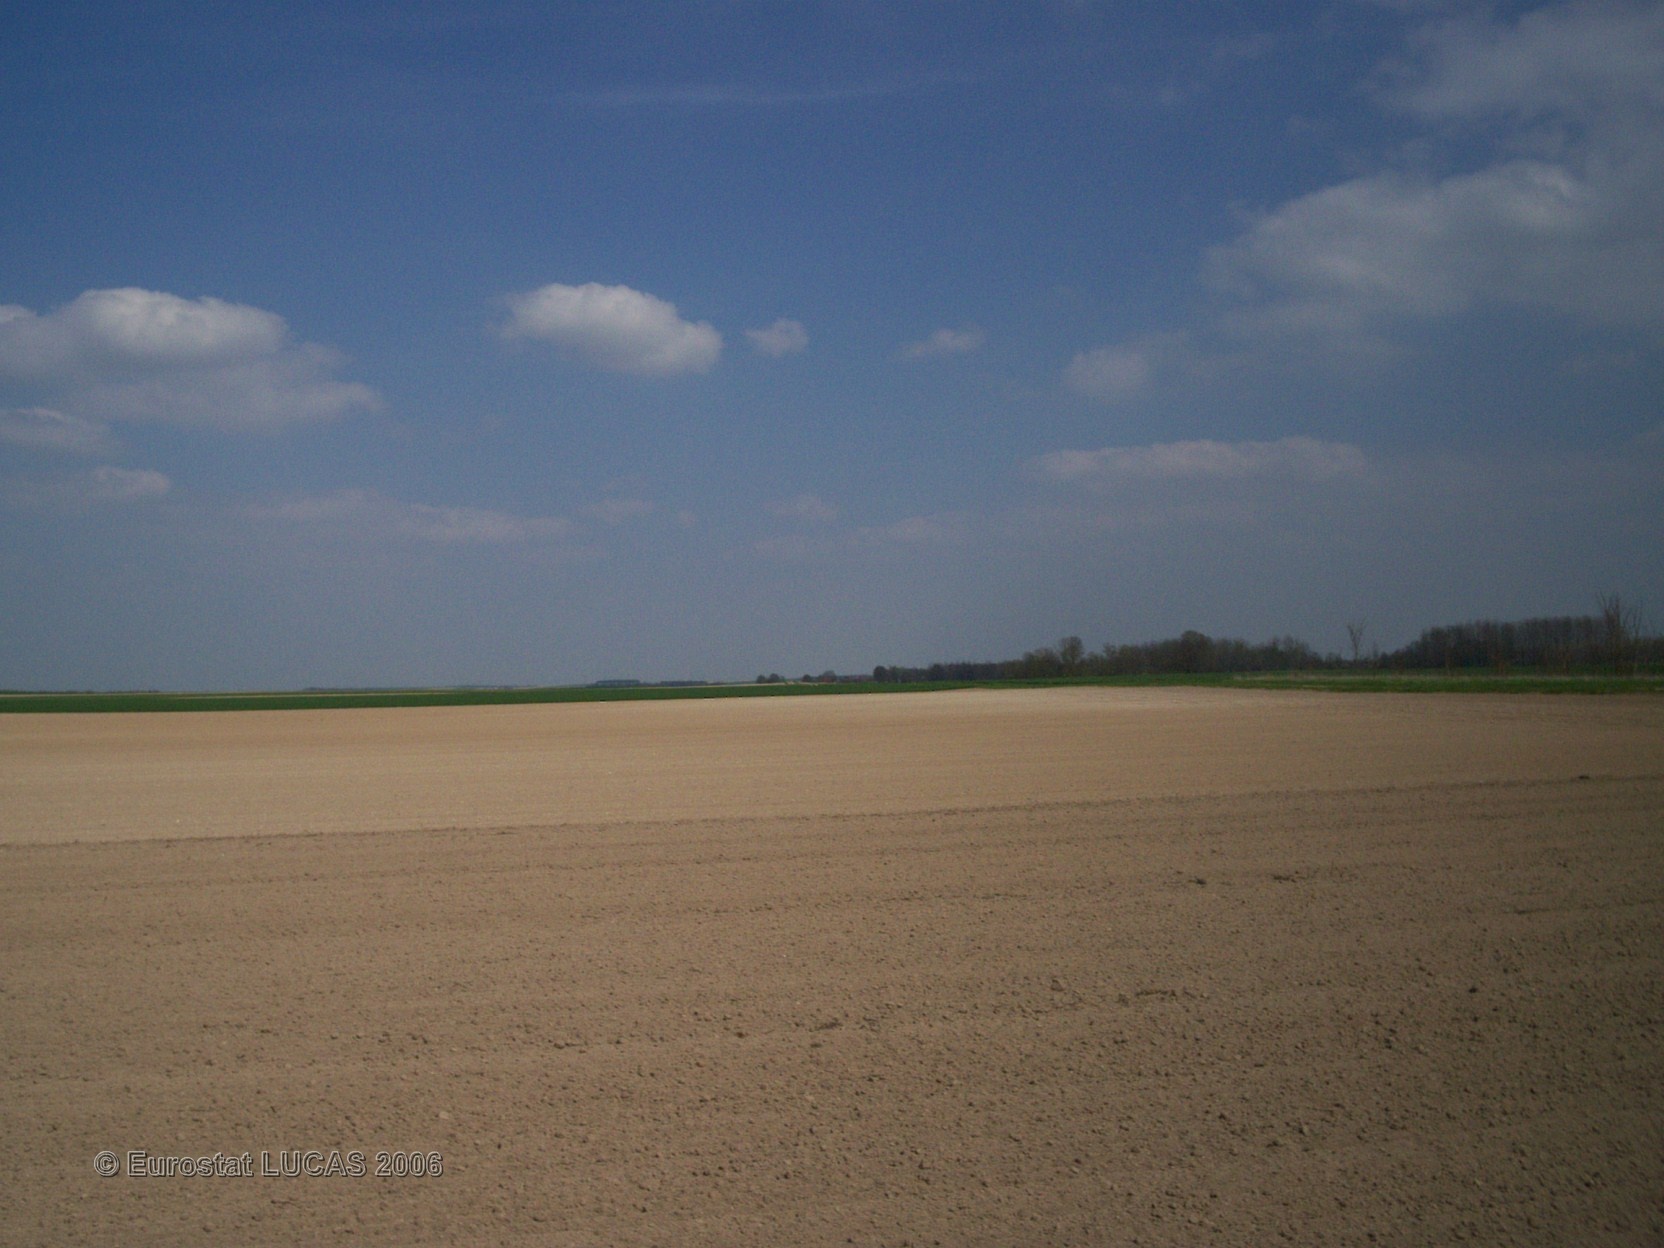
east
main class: Cropland
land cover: Potatoes
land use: Agriculture (excluding fallow land and kitchen gardens)
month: April
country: FR
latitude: 48.7053
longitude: 3.9211
